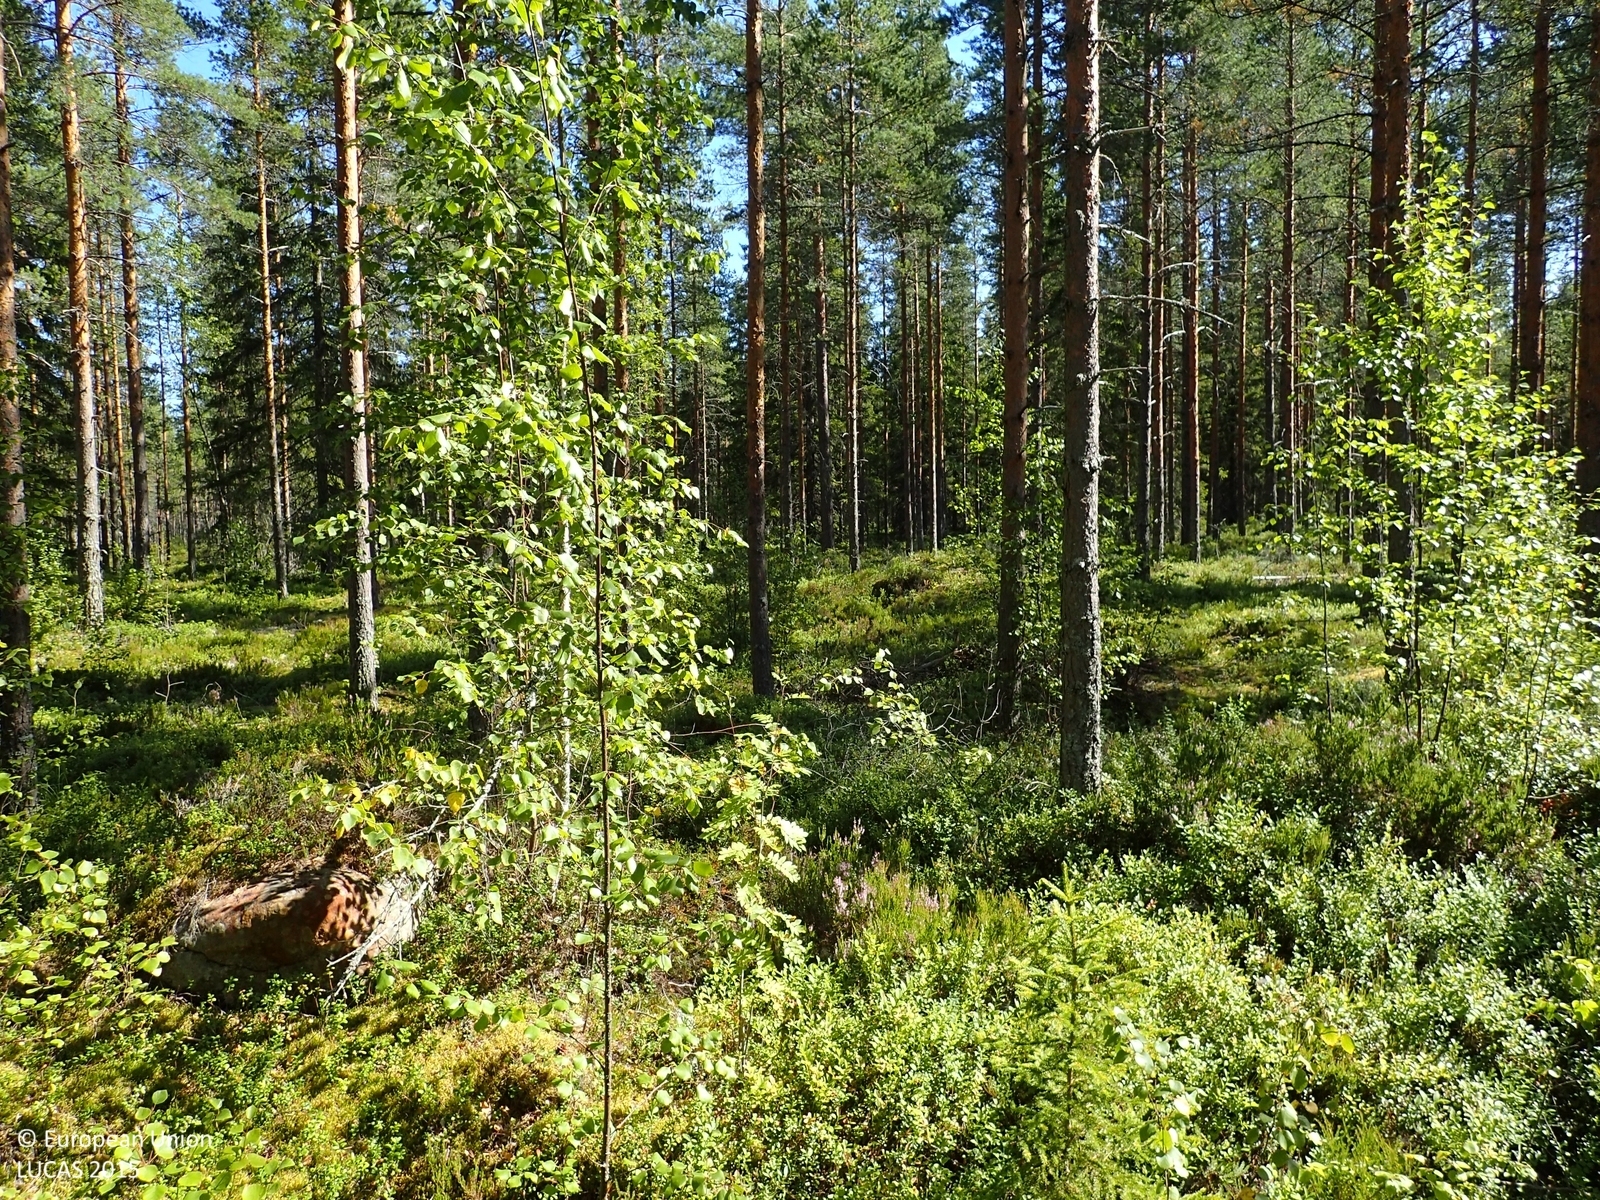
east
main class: Woodland
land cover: Pine dominated coniferous woodland
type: boreal forest
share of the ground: 50 - 75 %
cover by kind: coniferous forest trees 60 %, shrubs 25 %, broadleaved forest trees 10 %, lichens and mosses 5 %
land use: Forestry
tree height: > 5 m
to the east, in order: Pine dominated coniferous woodland; Ditches and canals; Pine dominated coniferous woodland; Pine dominated mixed woodland; Ditches and canals; Pine dominated mixed woodland; Ditches and canals; Pine dominated coniferous woodland; Ditches and canals; Pine dominated coniferous woodland; Ditches and canals; Shruby margins; Paved roads, cycling and walking lanes; Shruby margins; Ditches and canals
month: August
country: FI
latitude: 62.5919
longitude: 21.9455
